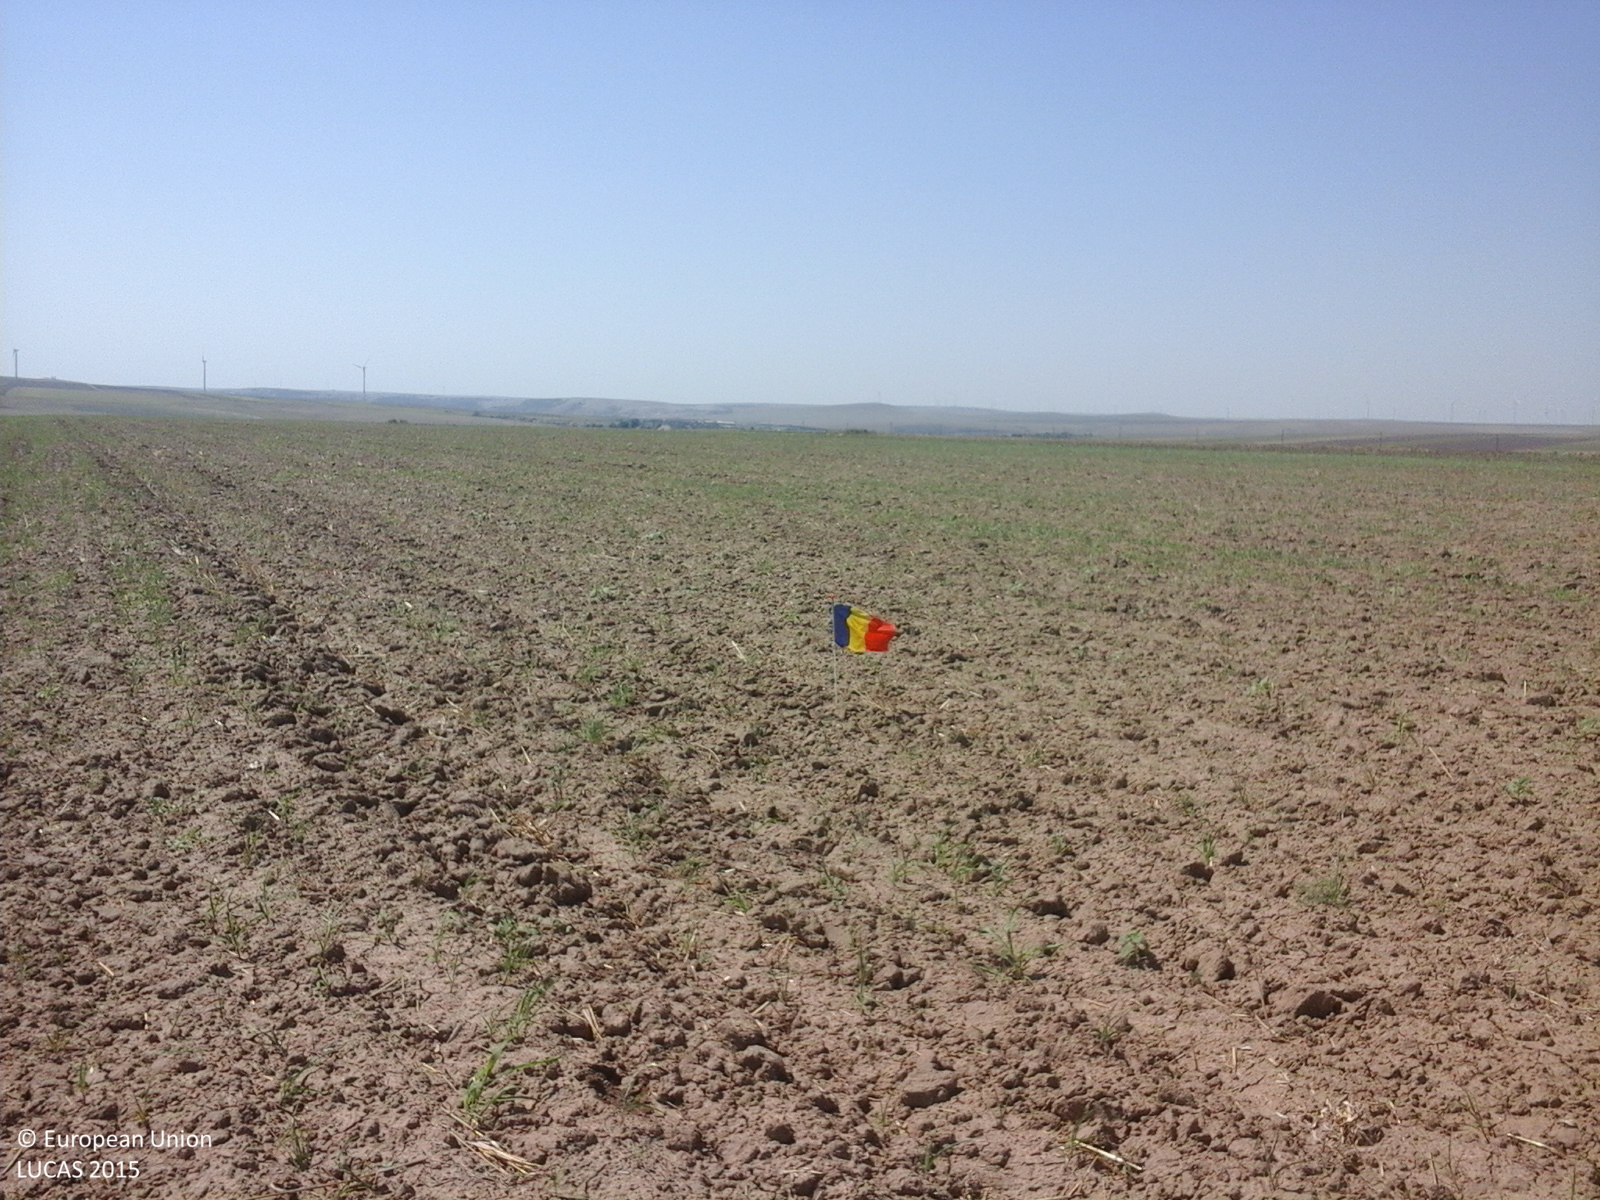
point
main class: Cropland
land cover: Durum wheat
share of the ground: < 10 %
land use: Agriculture (excluding fallow land and kitchen gardens)
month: August
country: RO
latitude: 44.5807
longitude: 28.4474
